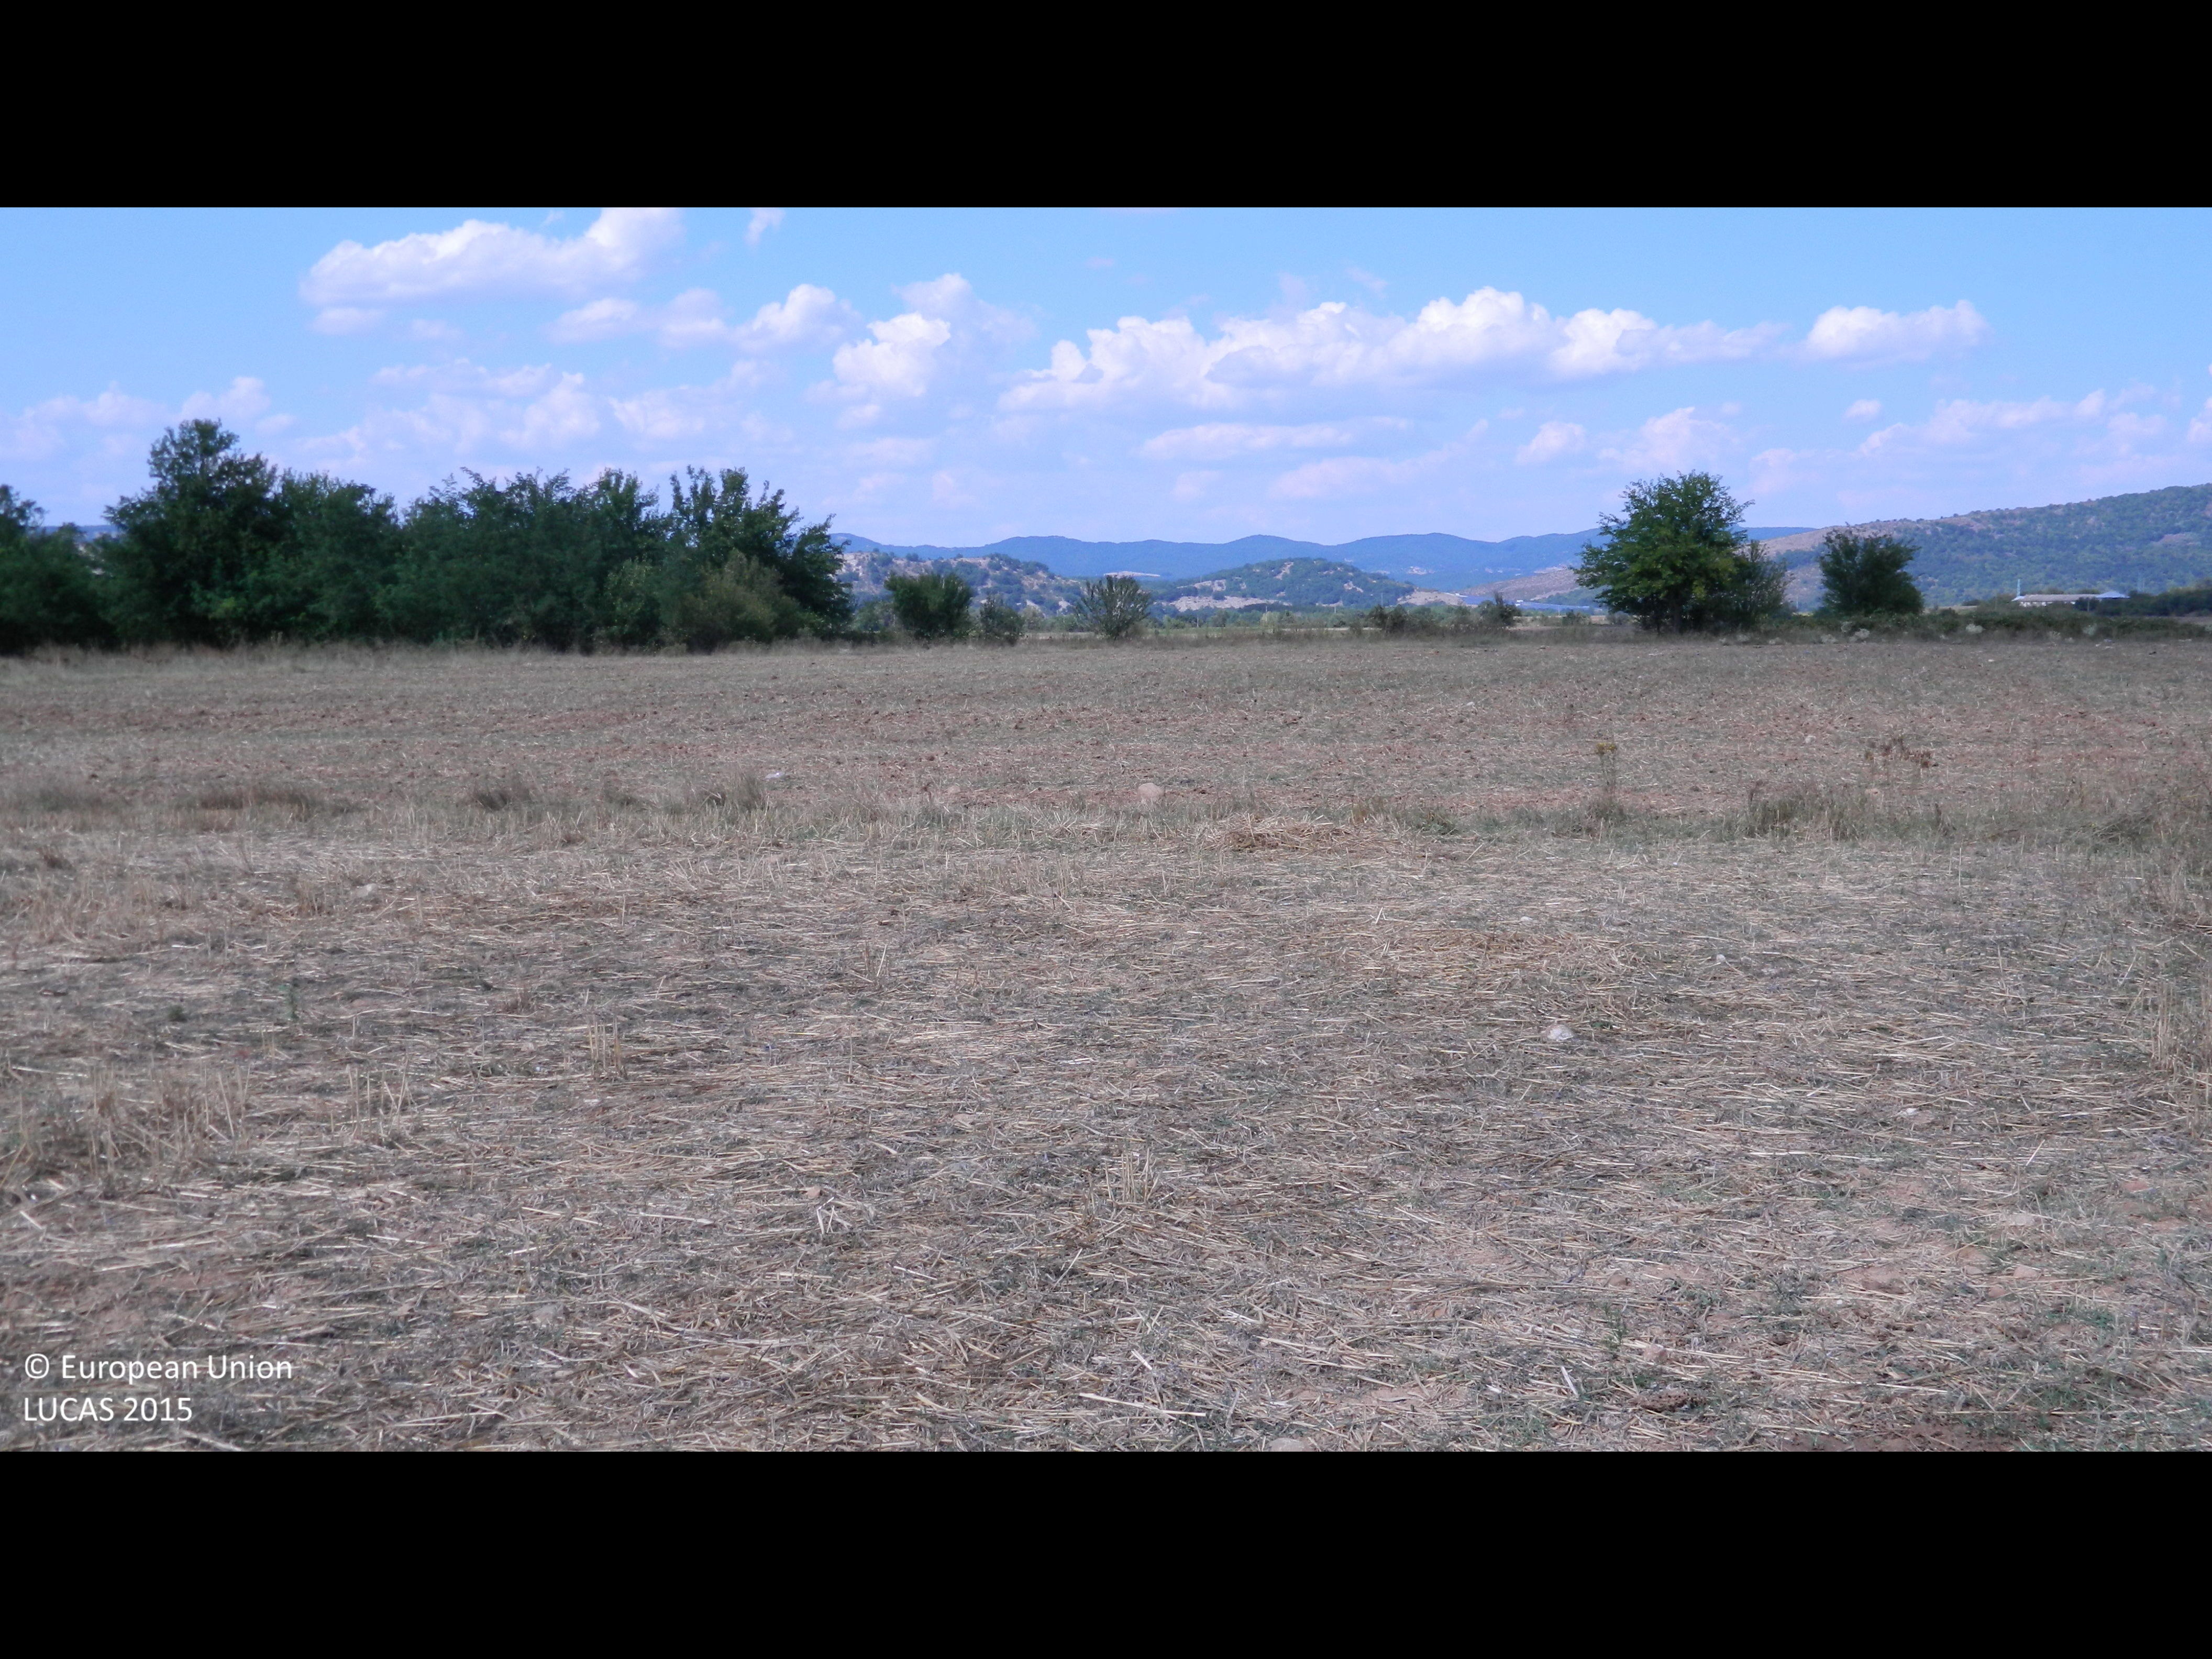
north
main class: Cropland
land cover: Common wheat
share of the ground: < 10 %
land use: Agriculture (excluding fallow land and kitchen gardens)
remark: Harvested field
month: August
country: BG
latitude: 41.6326
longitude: 25.7536
